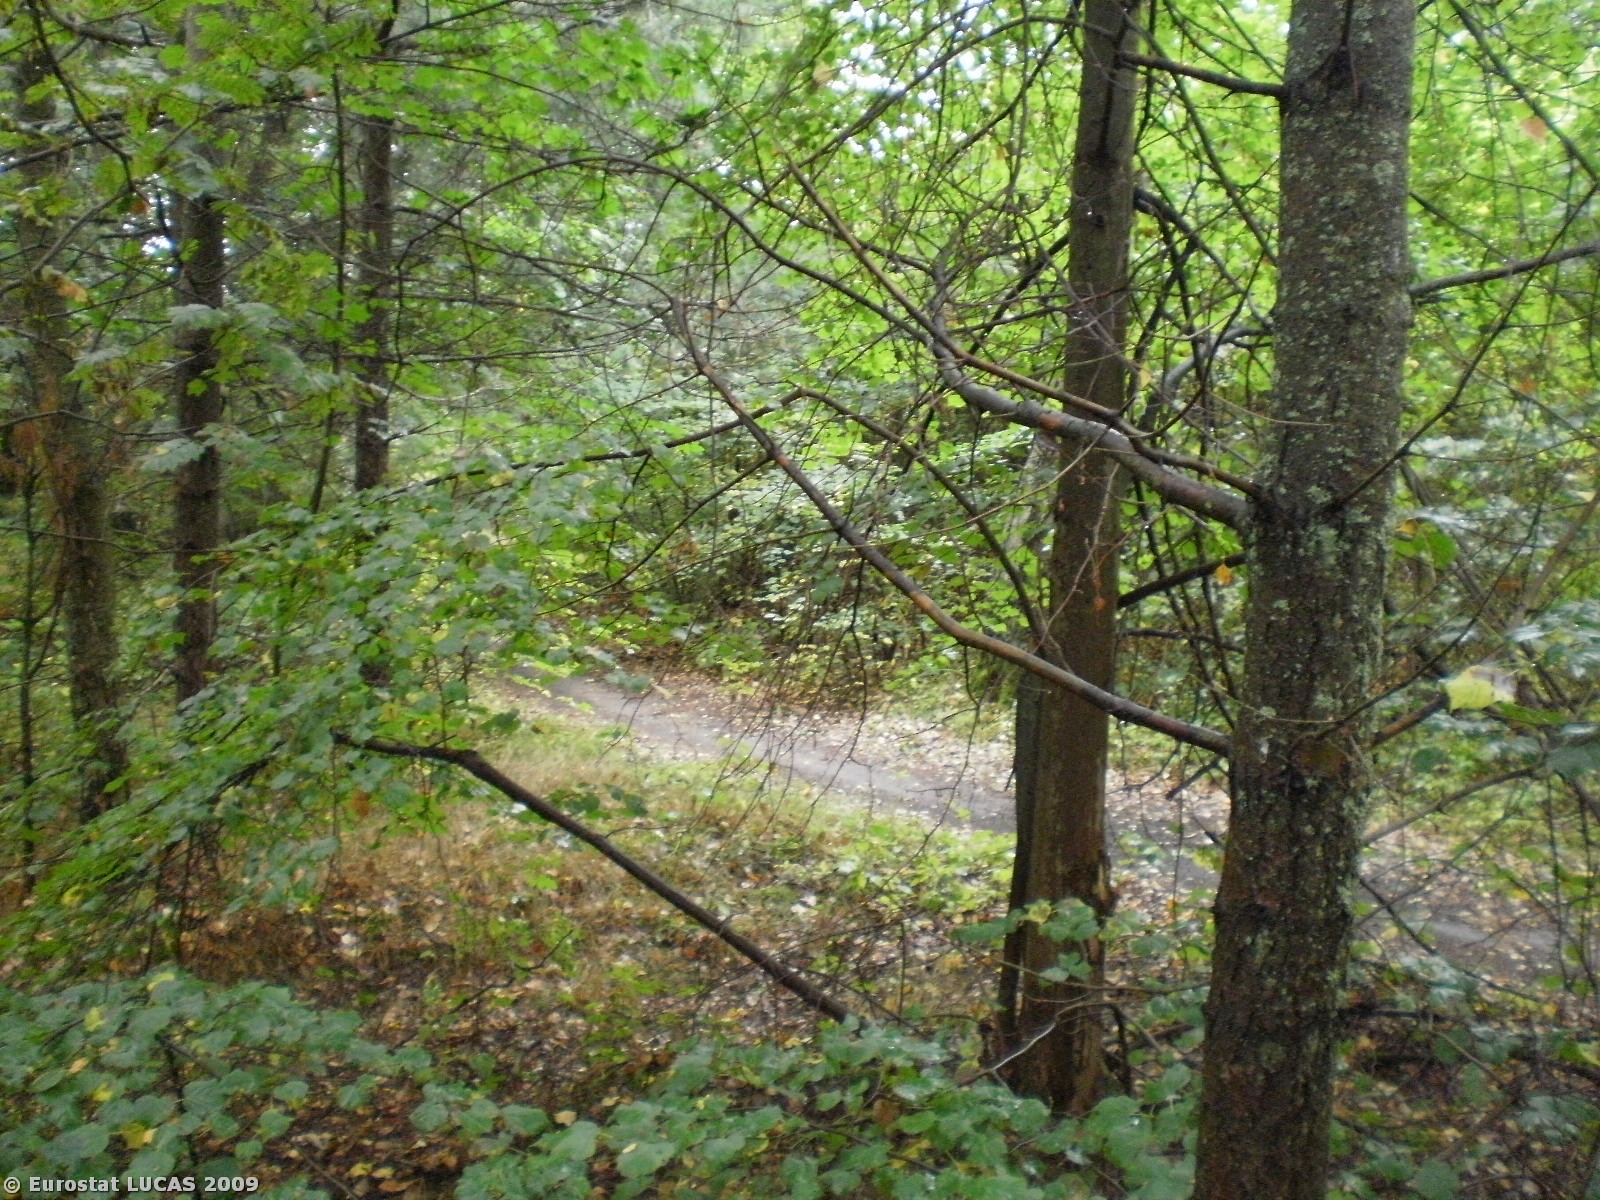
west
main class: Woodland
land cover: Mixed woodland
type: hemiboreal forest and nemoral coniferous forest and mixed broadleaved-coniferous forest
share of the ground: > 75 %
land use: Forestry
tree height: > 5 m
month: September
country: PL
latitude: 53.7506
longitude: 17.7318
